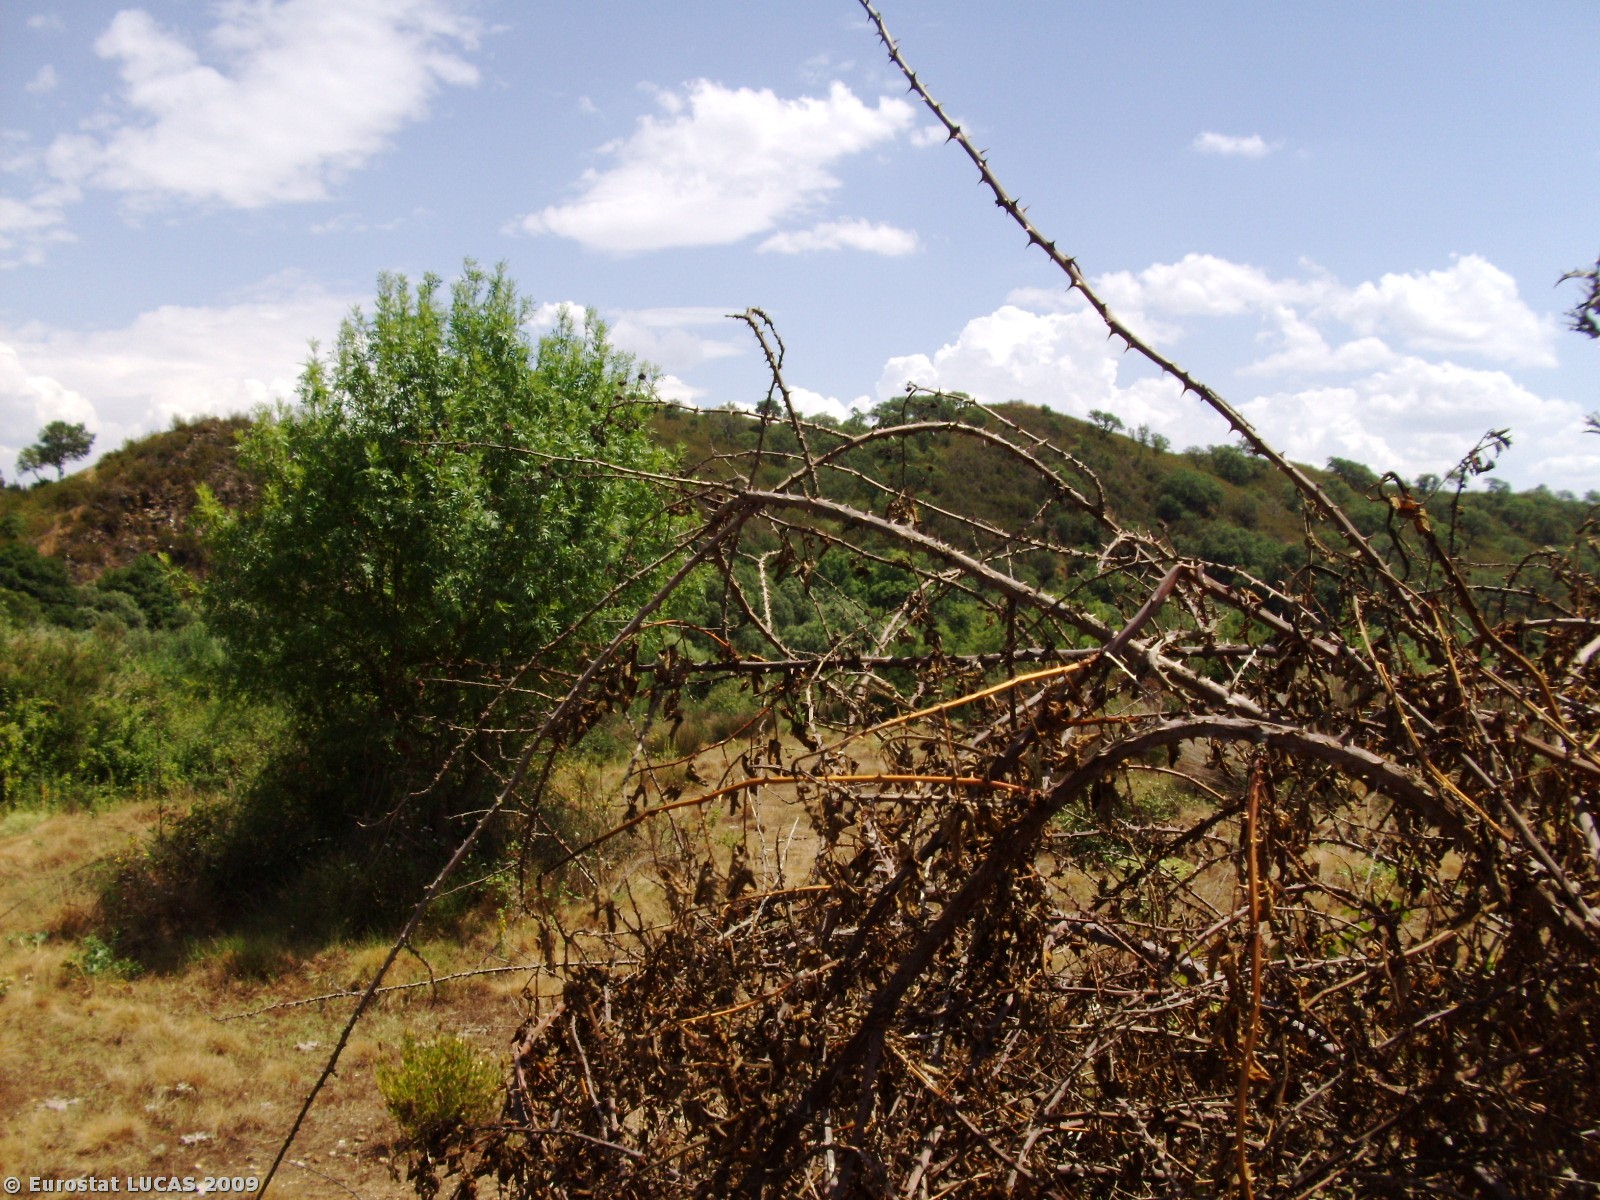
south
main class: Grassland
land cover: Spontaneously vegetated surfaces
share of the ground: 50 - 75 %
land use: Fallow land
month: June
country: PT
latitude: 37.5475
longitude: -8.5870
